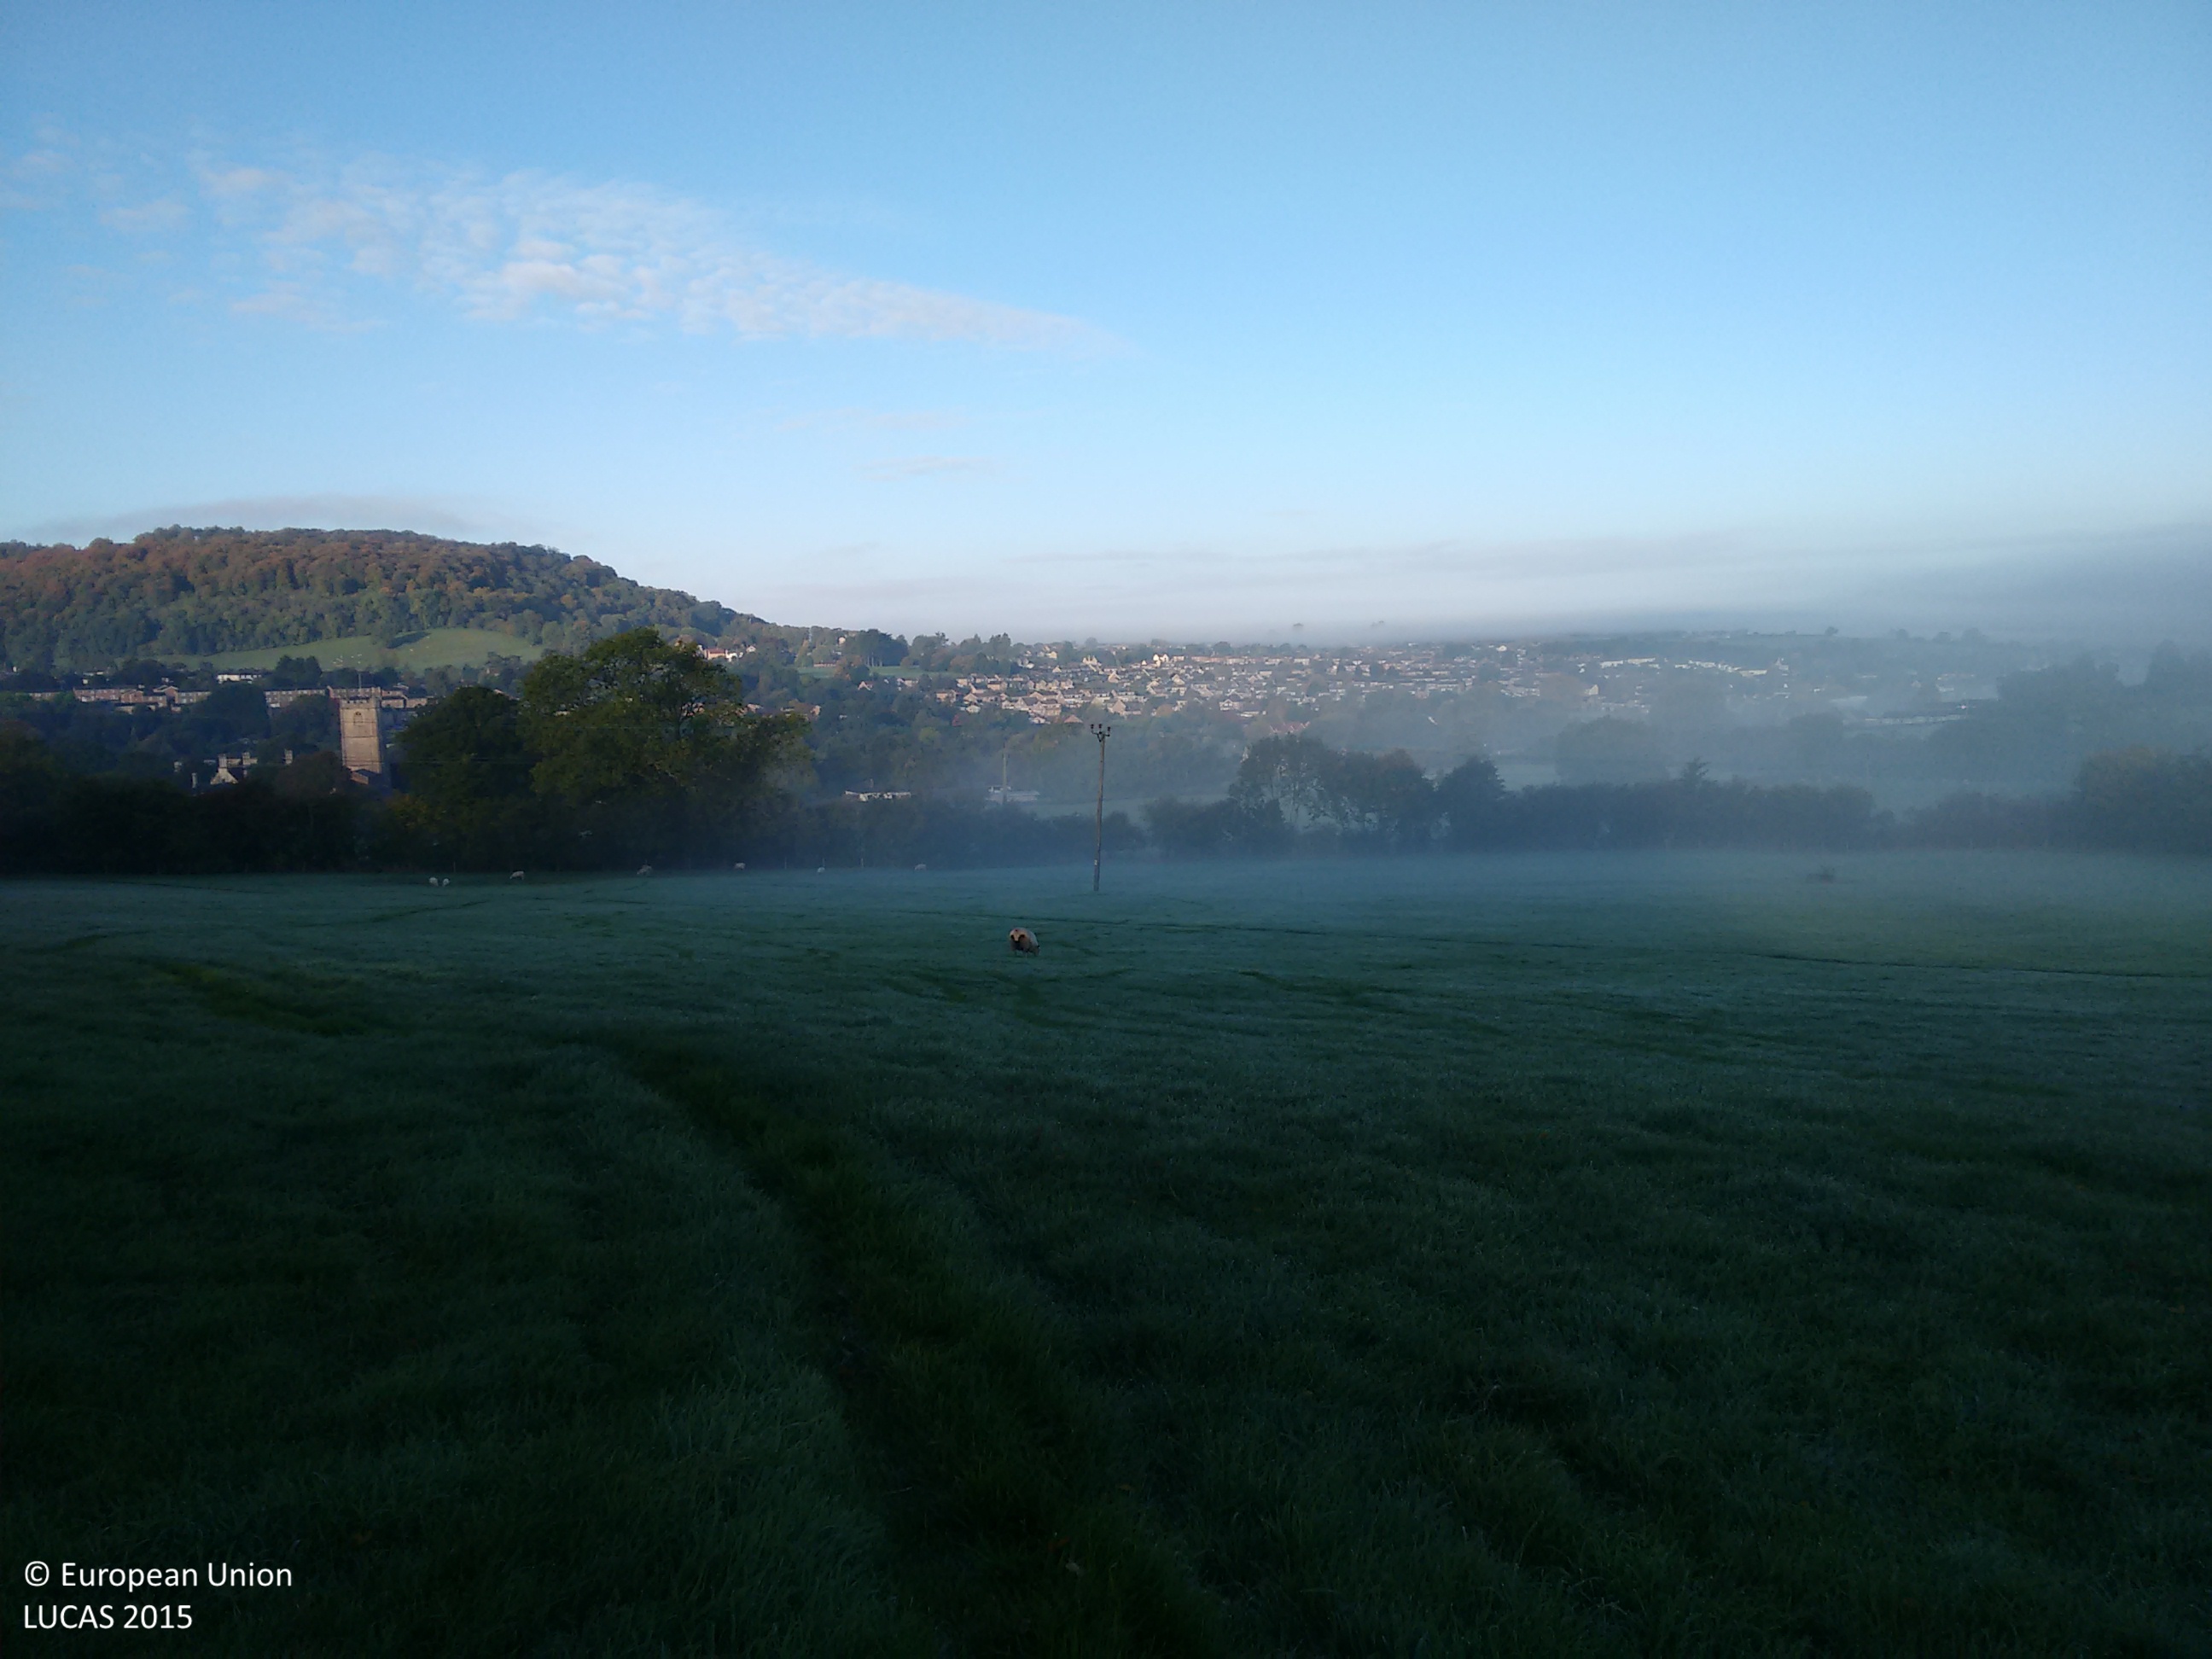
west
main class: Grassland
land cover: Grassland without tree/shrub cover
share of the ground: > 75 %
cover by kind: herbaceous plants 100 %
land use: Agriculture (excluding fallow land and kitchen gardens)
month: October
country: GB
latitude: 51.6935
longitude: -2.3464
